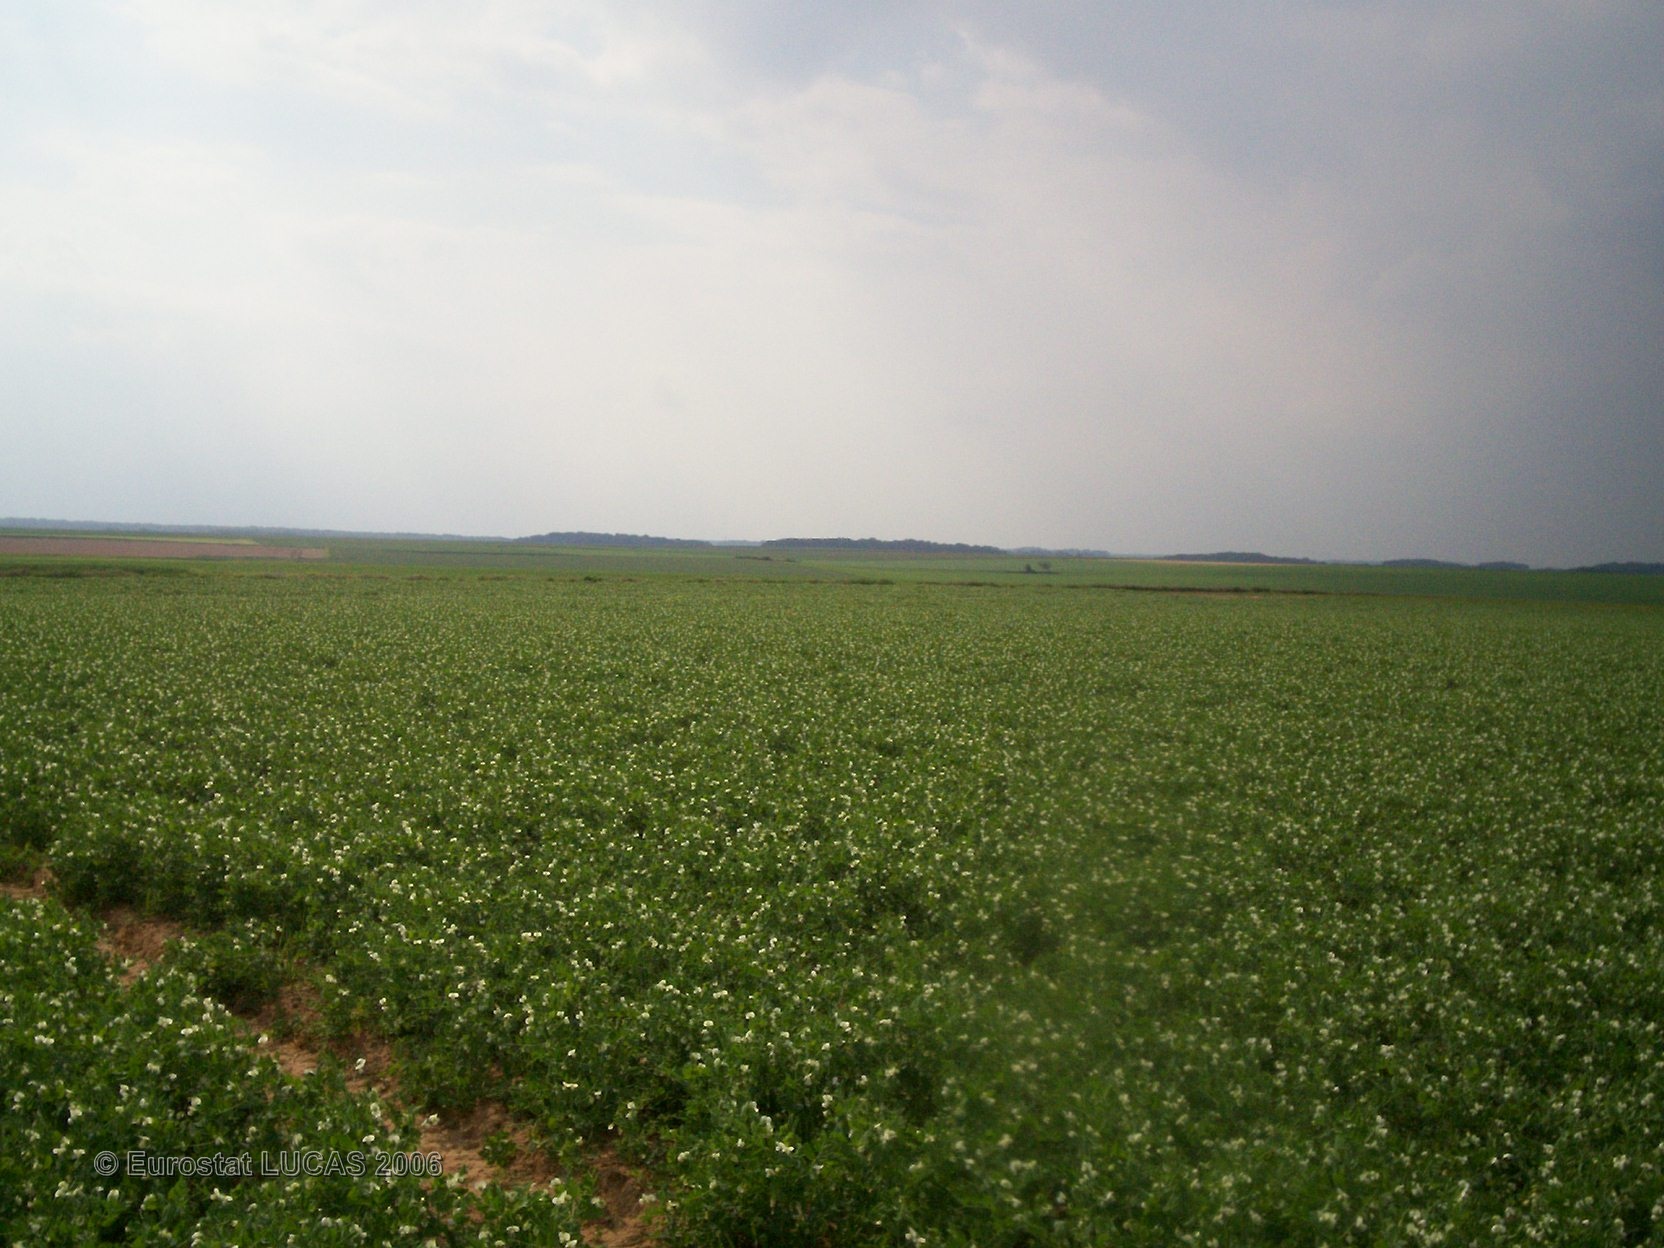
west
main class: Cropland
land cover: Other fresh vegetables
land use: Agriculture (excluding fallow land and kitchen gardens)
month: June
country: FR
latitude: 49.6801
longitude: 2.7130
